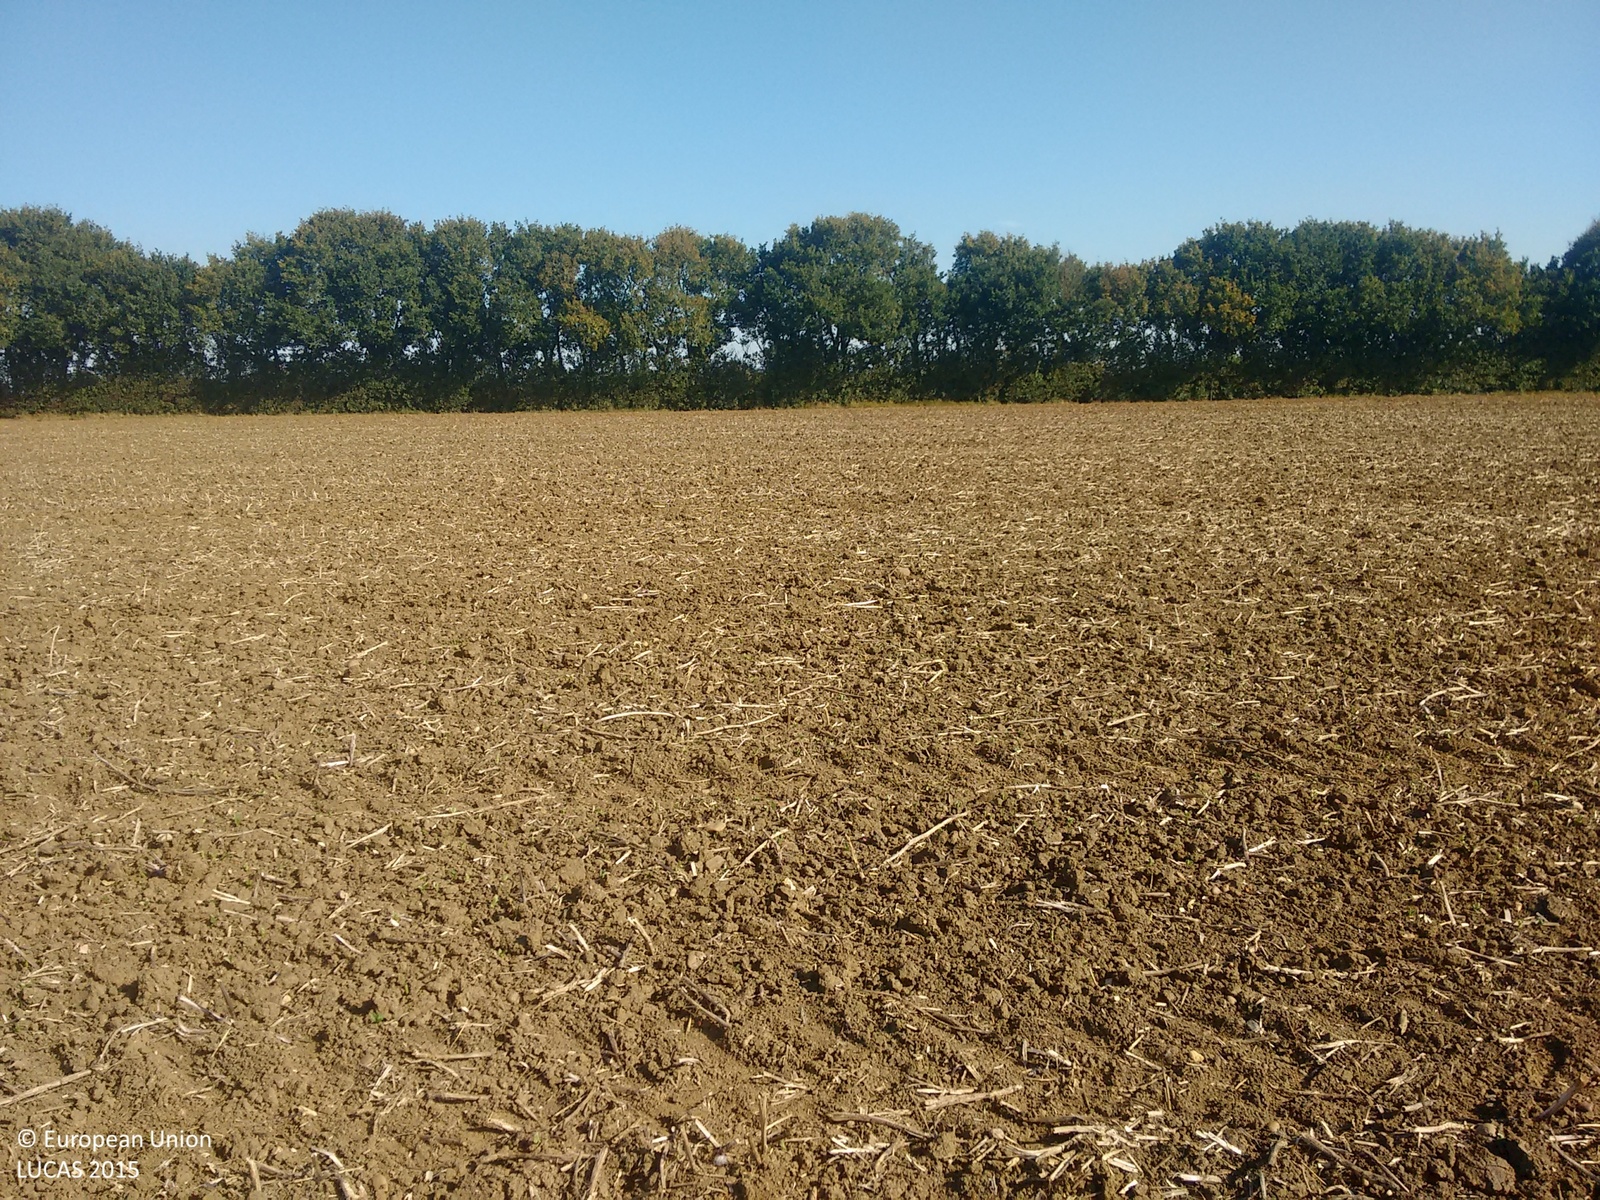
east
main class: Cropland
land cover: Rape and turnip rape
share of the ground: 10 - 25 %
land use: Agriculture (excluding fallow land and kitchen gardens)
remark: Harvested field
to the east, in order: Rape and turnip rape; Managed hedges; Ditches and canals; Managed hedges; Grass margins; Tracks; Common wheat; Grass margins; Ditches and canals; Managed hedges; Other bare soil
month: September
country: GB
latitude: 52.3937
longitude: -0.3674
